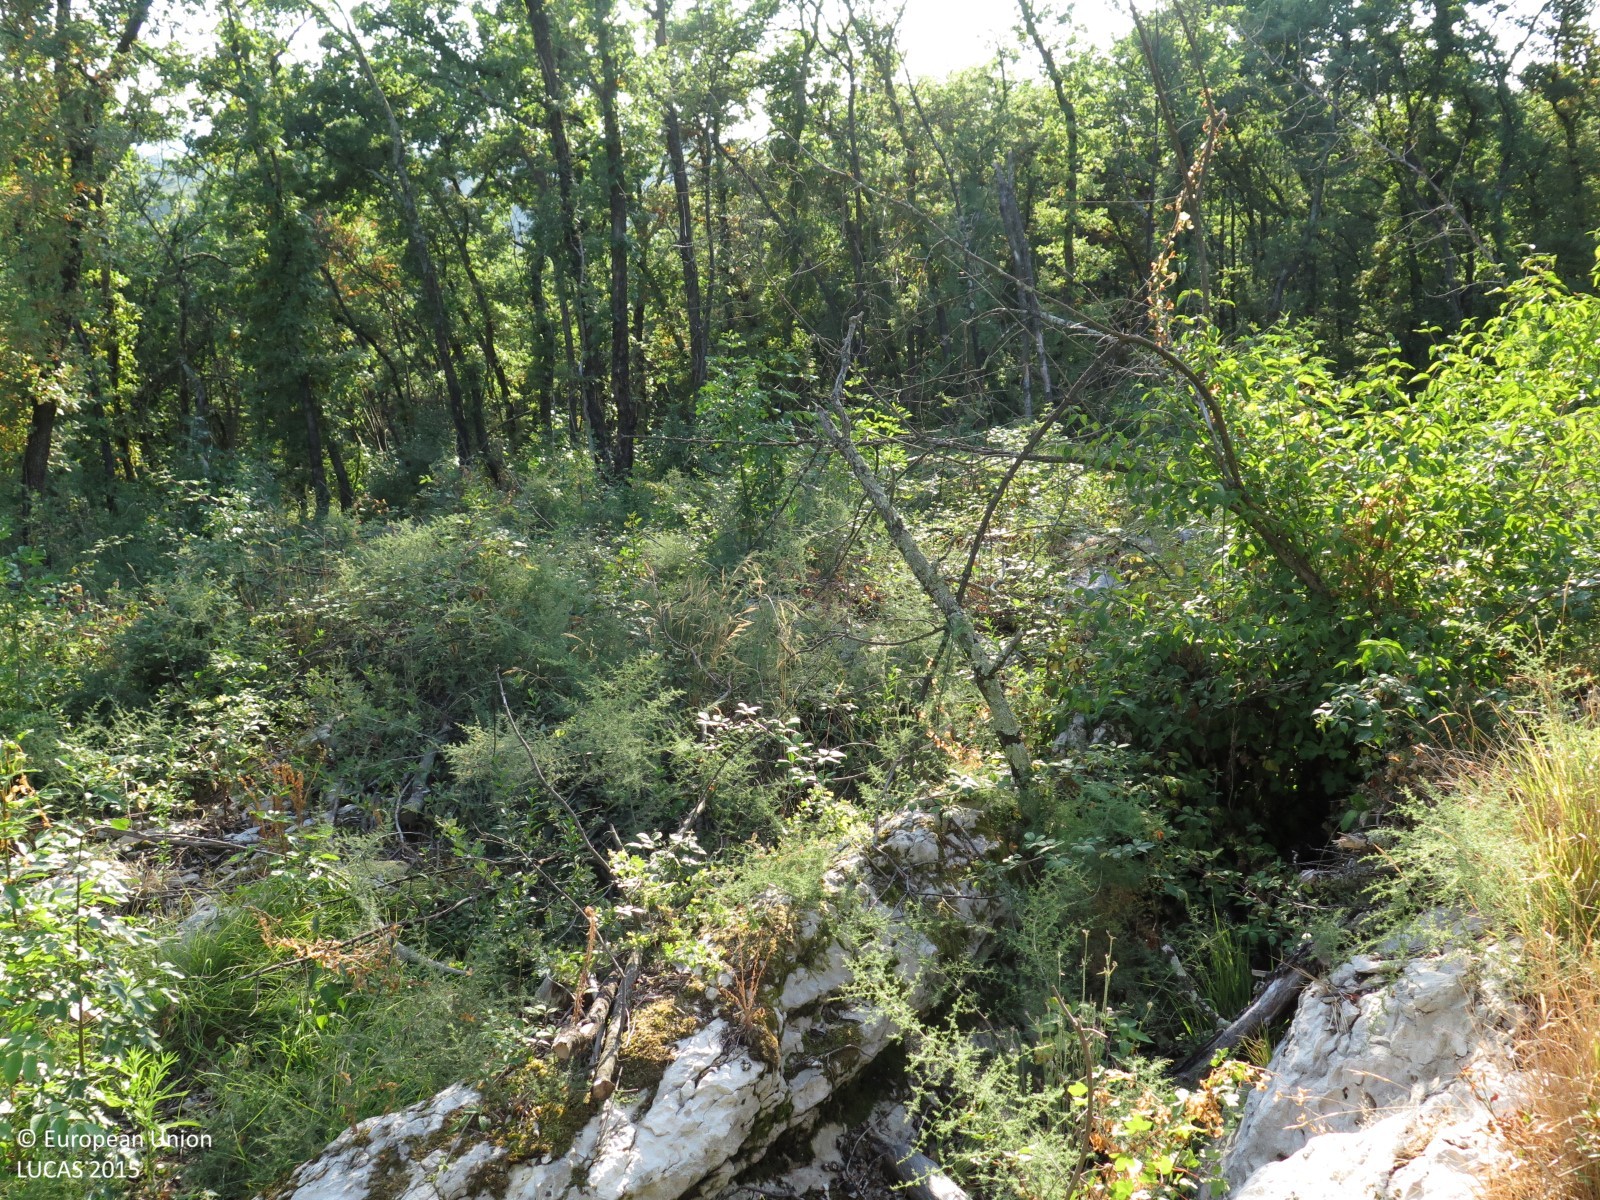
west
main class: Woodland
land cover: Broadleaved woodland
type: acidophilous oak and oak-birch forest
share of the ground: > 75 %
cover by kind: broadleaved forest trees 90 %, herbaceous plants 10 %
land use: Semi-natural and natural areas not in use
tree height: > 5 m
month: July
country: HR
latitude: 45.3539
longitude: 14.0669
